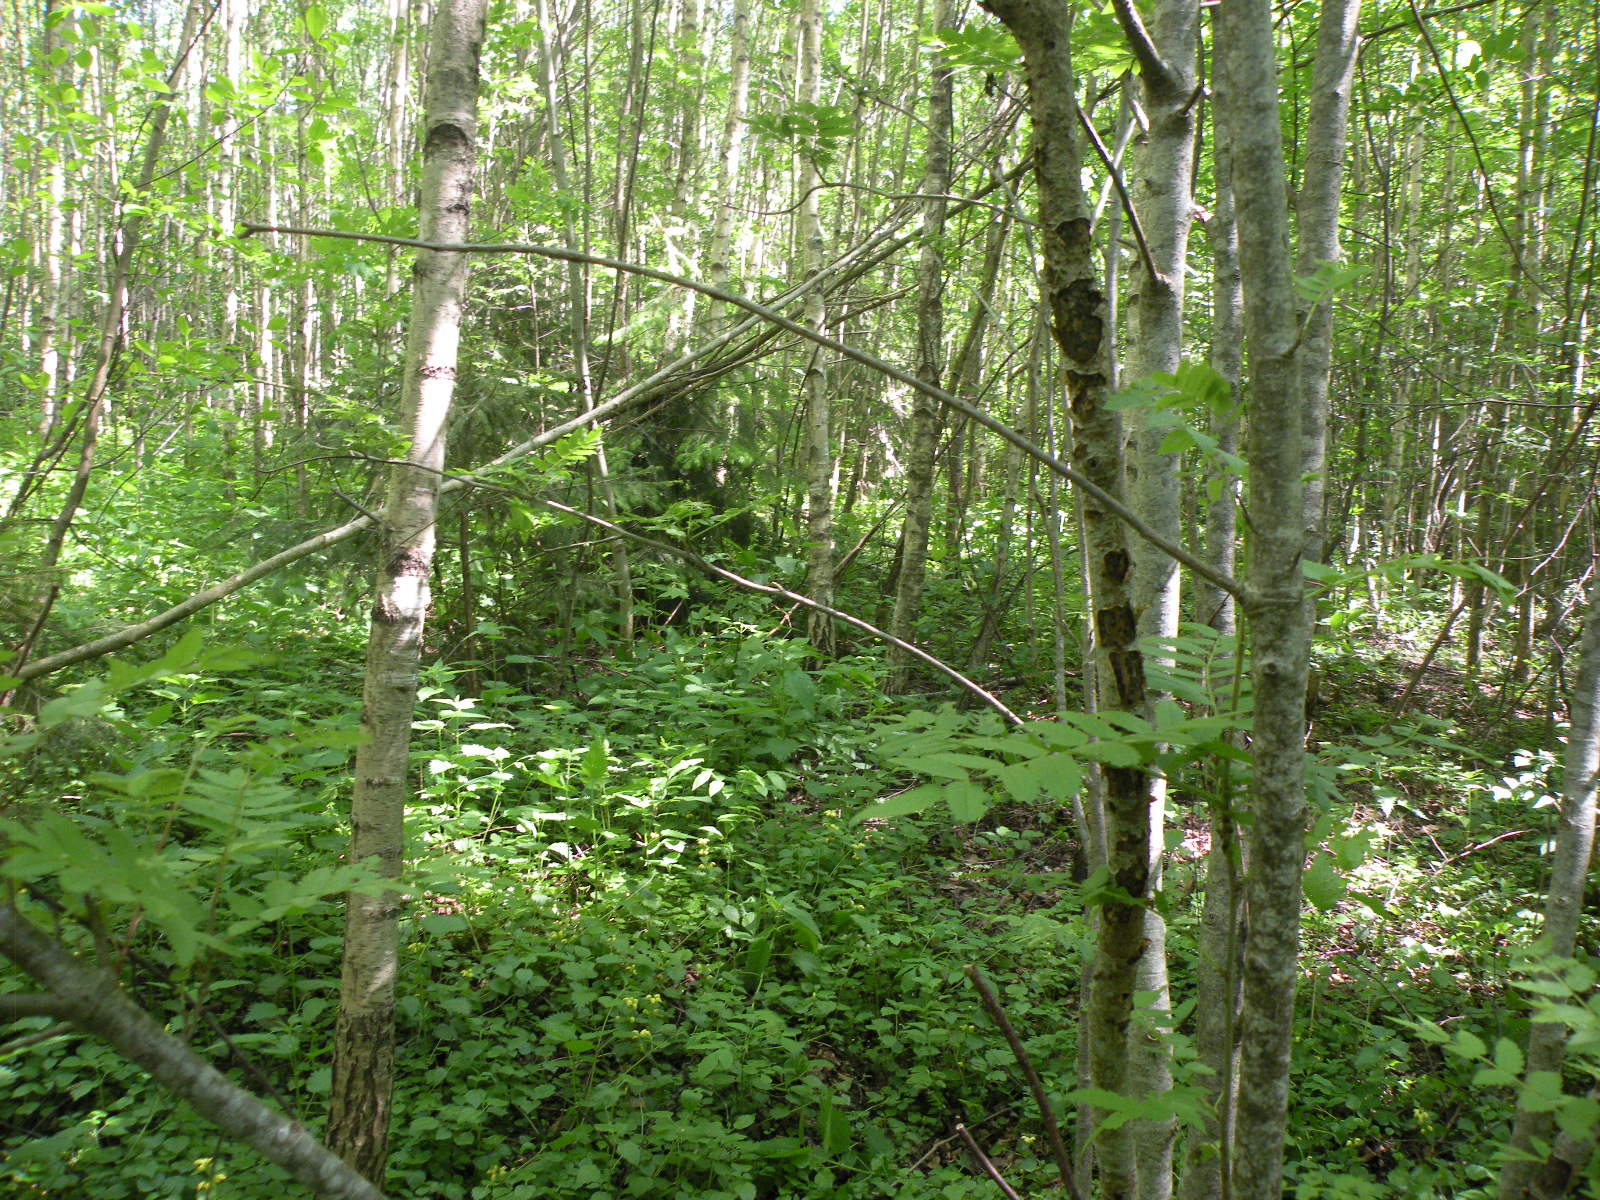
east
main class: Woodland
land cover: Broadleaved woodland
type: non-riverine alder, birch or aspen forest
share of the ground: > 75 %
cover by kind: broadleaved forest trees 80 %, shrubs 10 %, herbaceous plants 10 %
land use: Forestry
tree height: > 5 m
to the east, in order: Broadleaved woodland; Spruce dominated mixed woodland; Broadleaved woodland
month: May
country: LV
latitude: 55.9736
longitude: 26.2138
